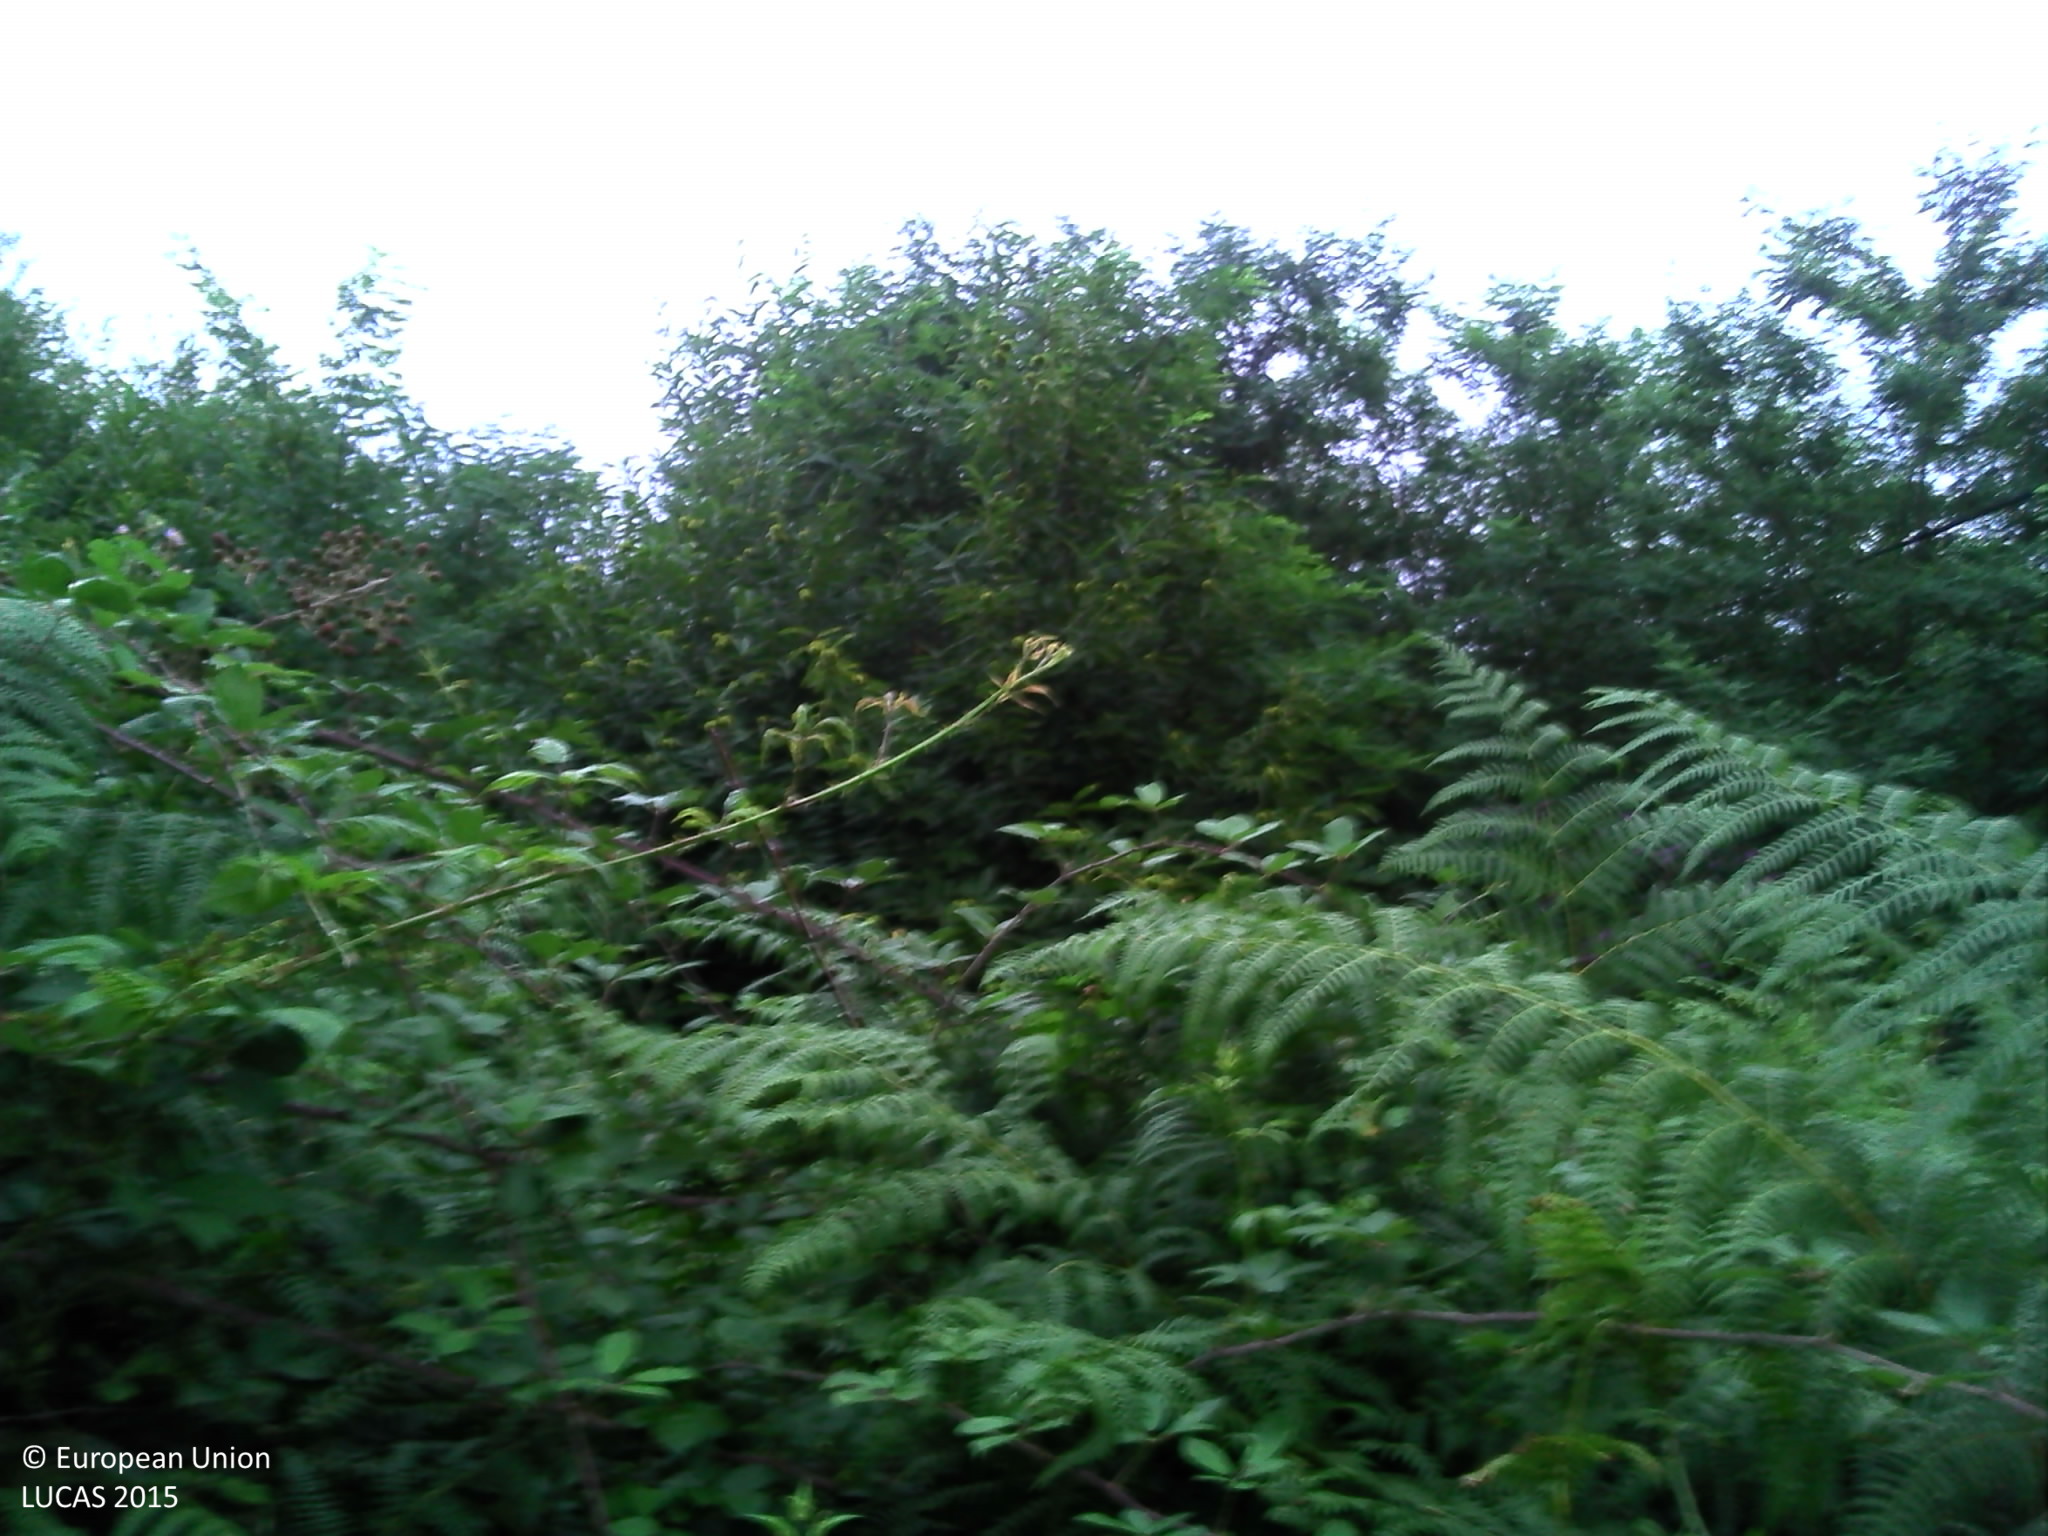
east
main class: Shrubland
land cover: Shrubland with sparse tree cover
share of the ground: > 75 %
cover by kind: shrubs 80 %, herbaceous plants 15 %, broadleaved forest trees 5 %
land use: Semi-natural and natural areas not in use
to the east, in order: Shrubland with sparse tree cover; Broadleaved woodland; Artificial constructions in urban areas; Broadleaved woodland; Grassland without tree/shrub cover; Shrubland with sparse tree cover; Artificial constructions in urban areas
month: August
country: FR
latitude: 43.1731
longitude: -1.2446
